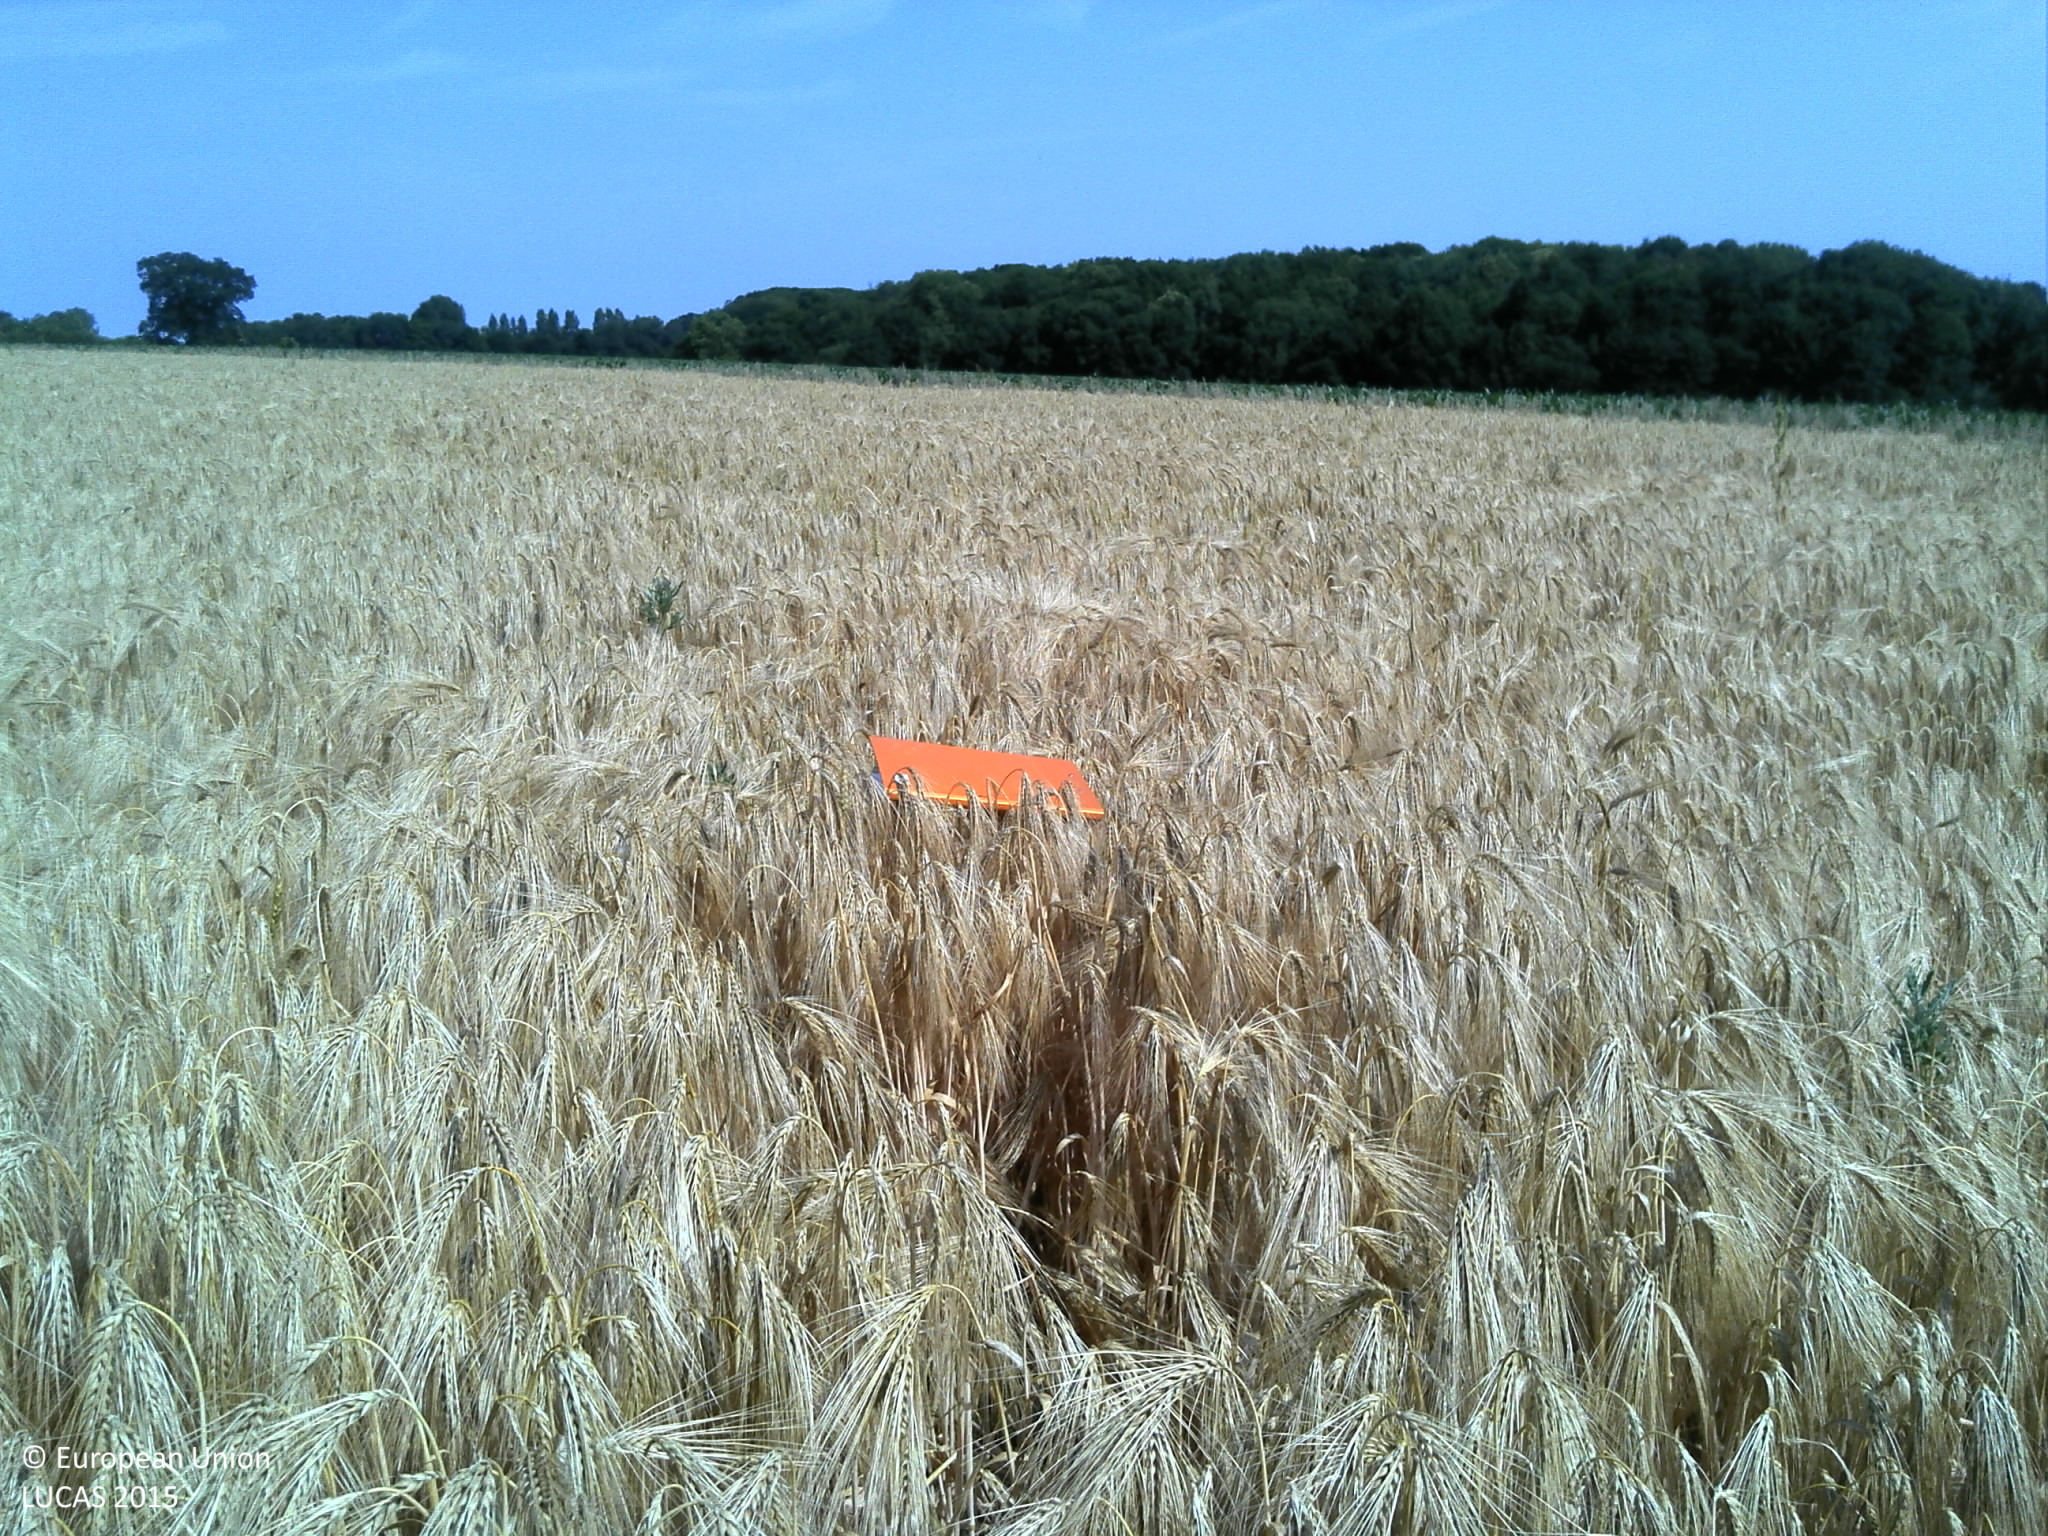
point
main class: Cropland
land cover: Barley
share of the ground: > 75 %
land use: Agriculture (excluding fallow land and kitchen gardens)
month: July
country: FR
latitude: 49.5184
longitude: 1.2080
